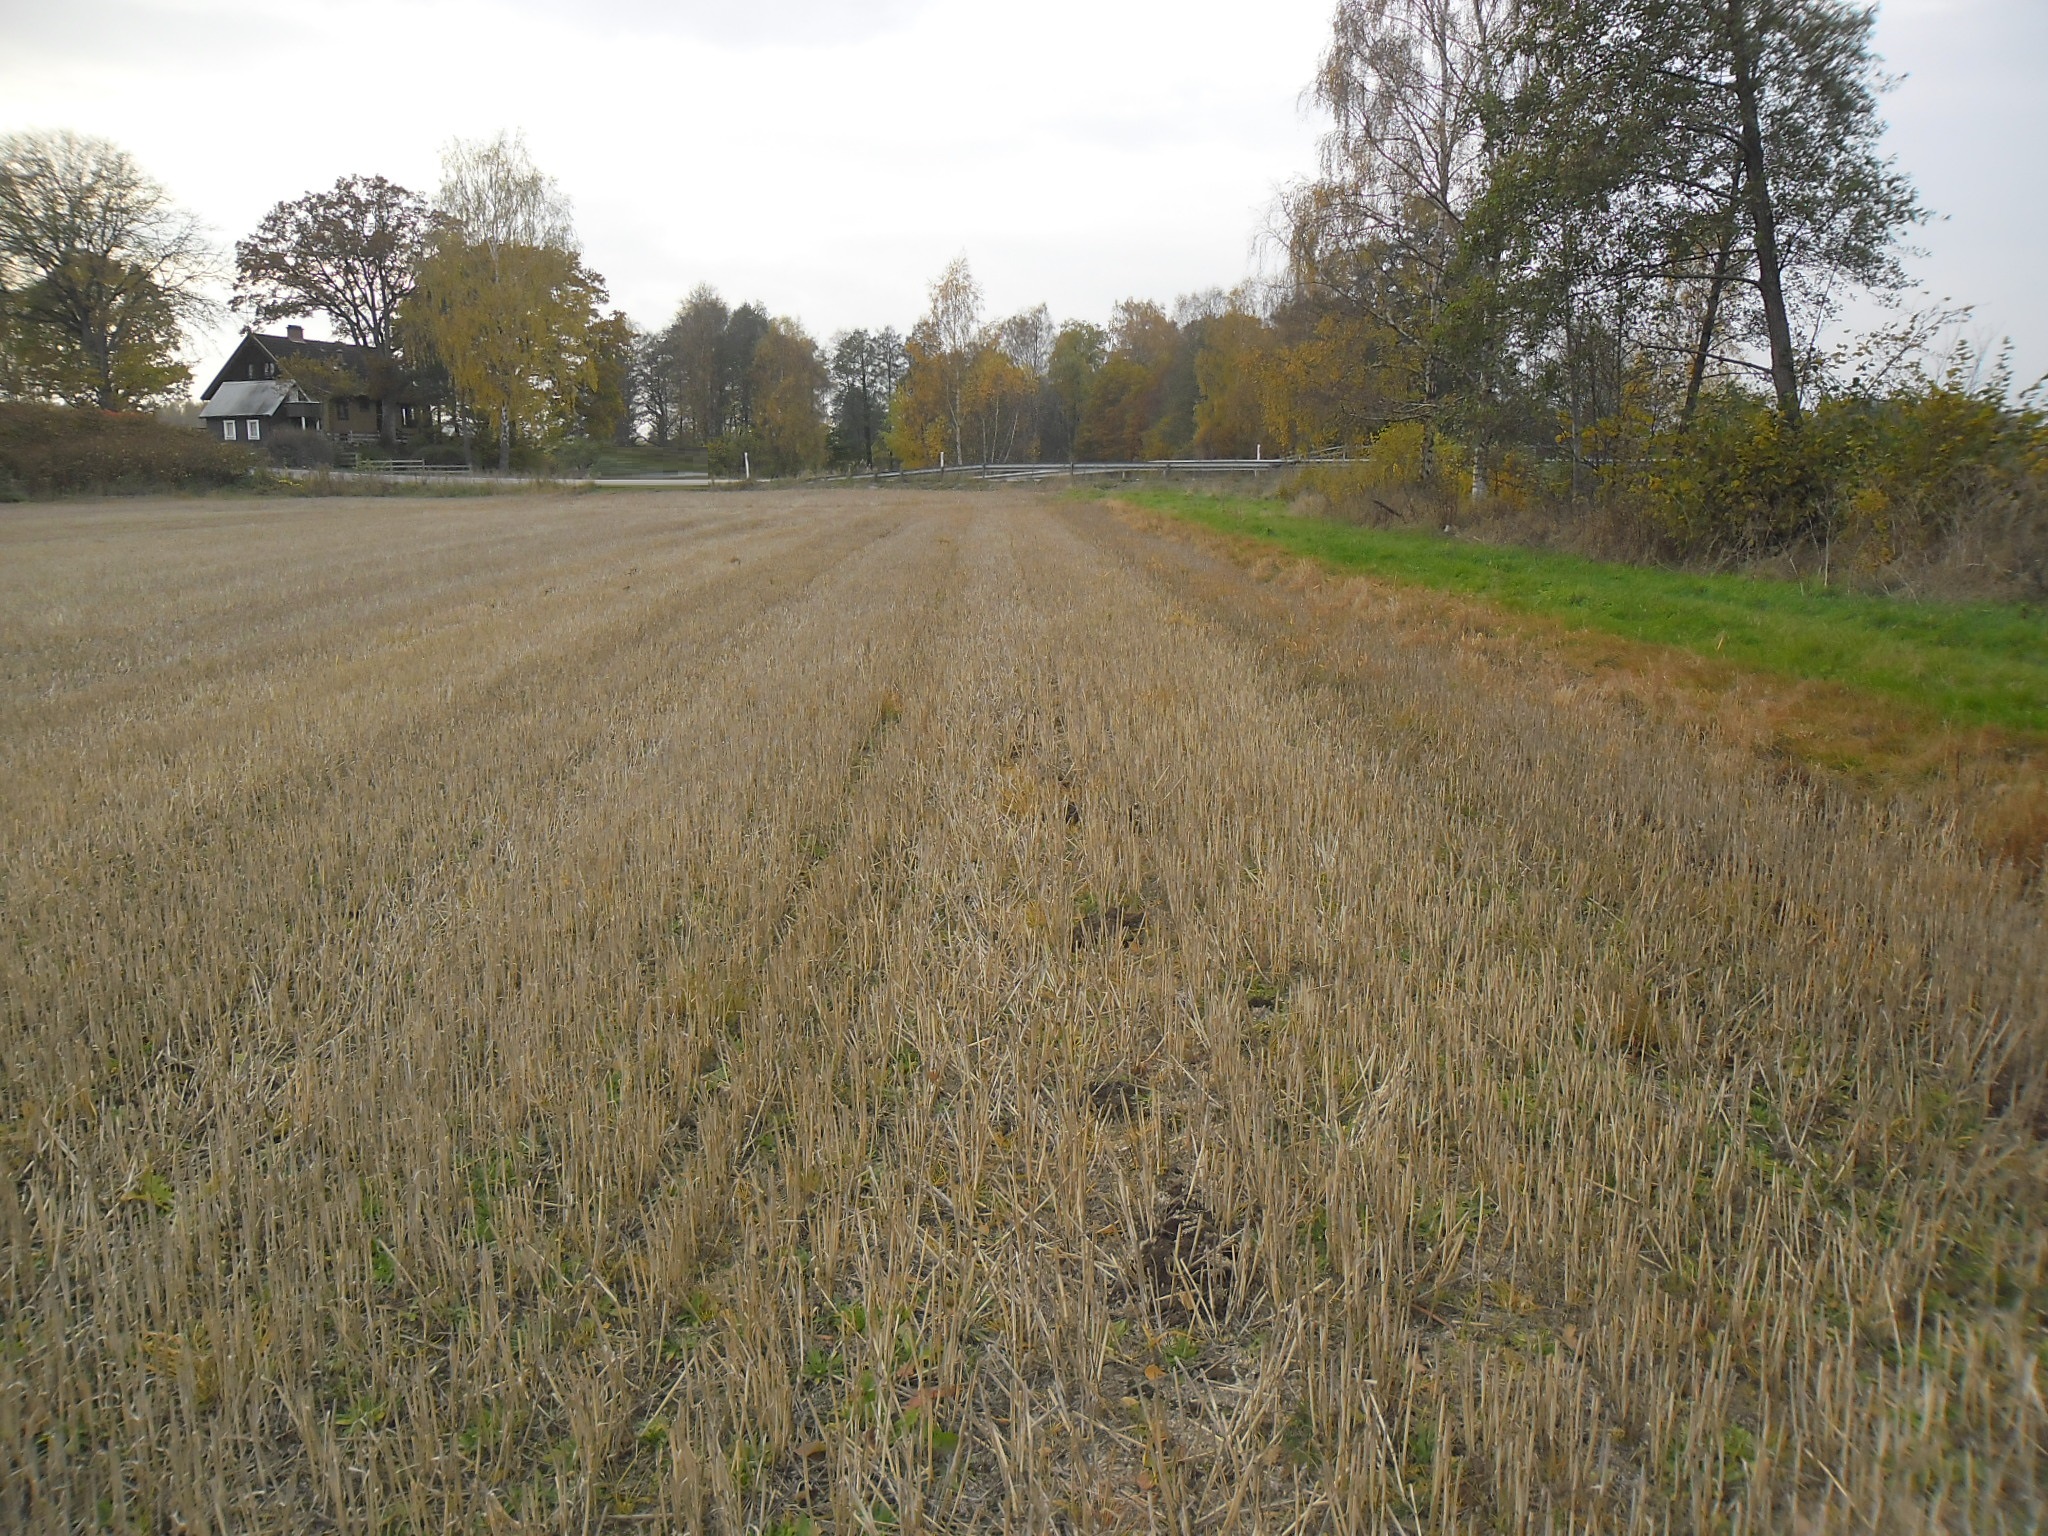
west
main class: Cropland
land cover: Common wheat
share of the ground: 25 - 50 %
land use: Agriculture (excluding fallow land and kitchen gardens)
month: October
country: SE
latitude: 56.1700
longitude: 13.7179
